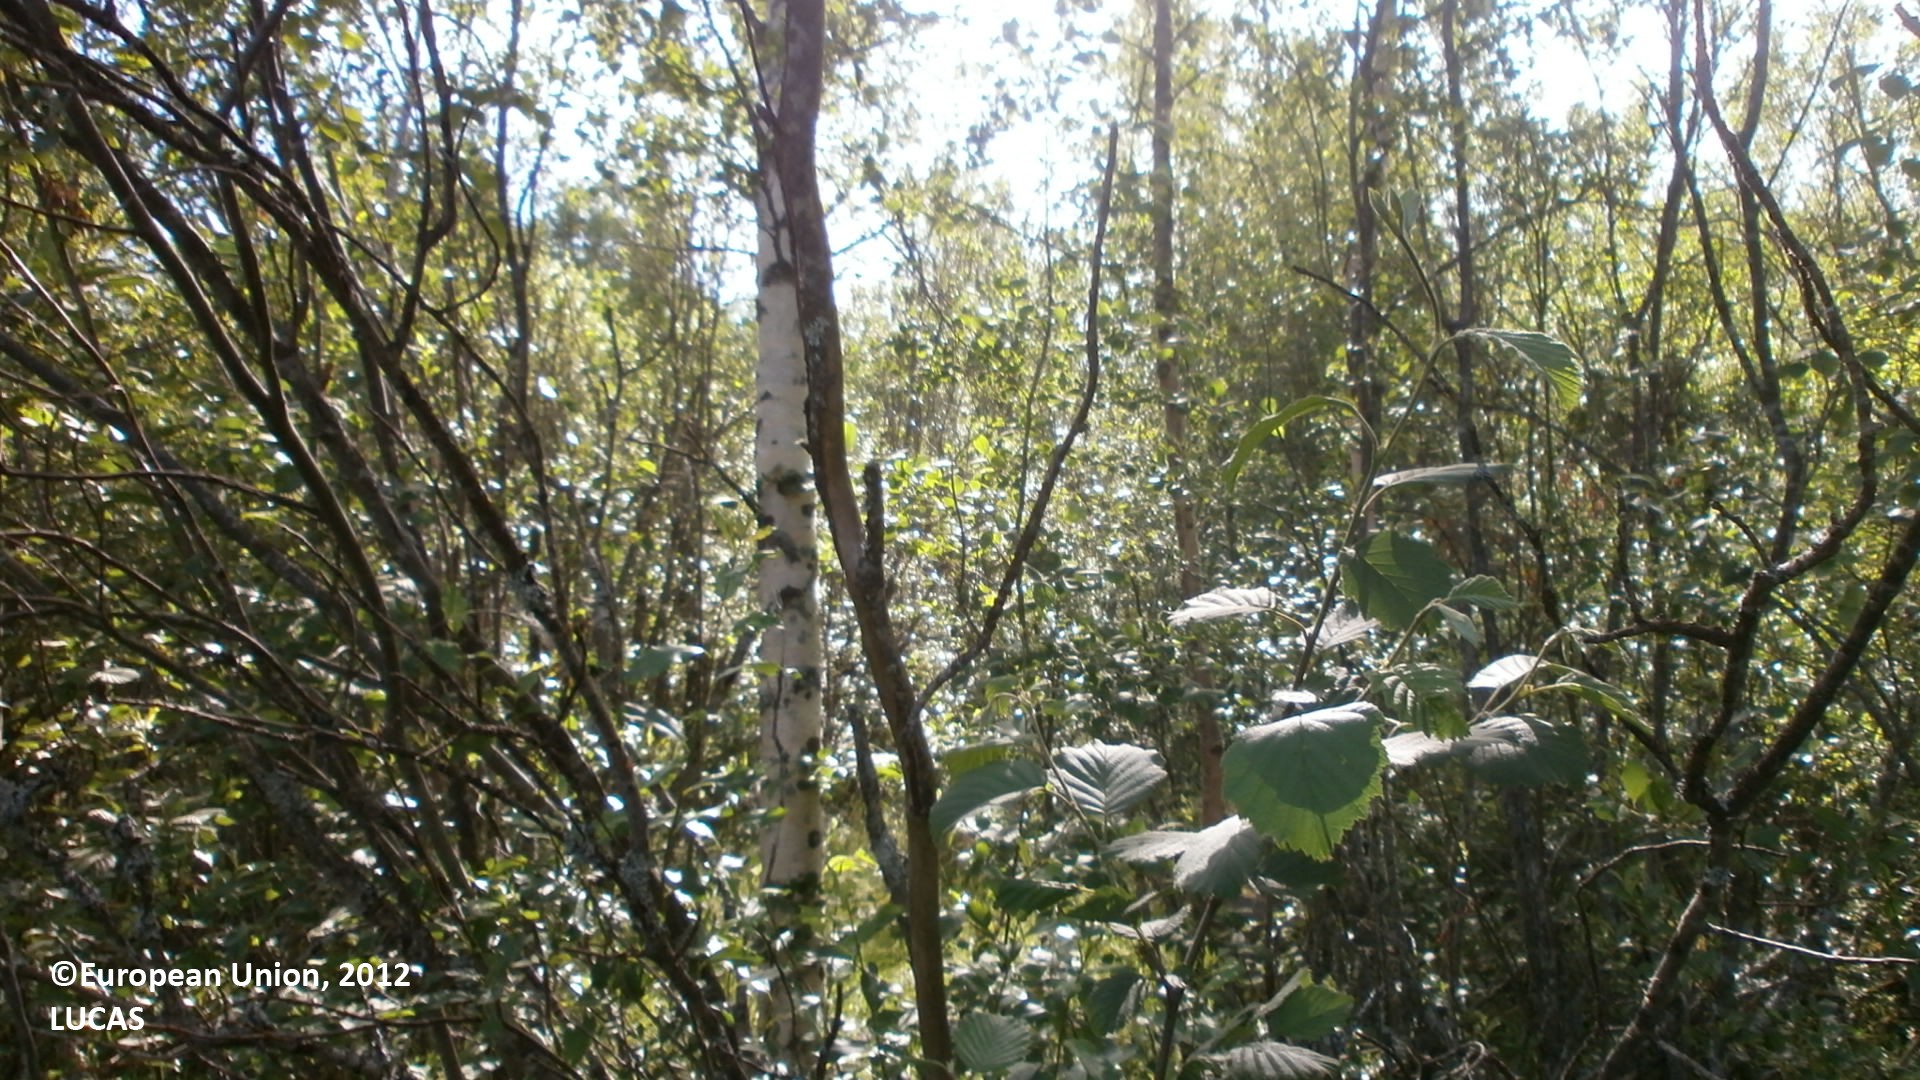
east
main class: Woodland
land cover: Broadleaved woodland
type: boreal forest
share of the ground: > 75 %
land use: Forestry
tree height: > 5 m
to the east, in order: Broadleaved woodland; Ditches and canals; Broadleaved woodland; Ditches and canals; Broadleaved woodland; Spruce dominated mixed woodland; Pine dominated mixed woodland; Ditches and canals; Shruby margins; Tracks; Shruby margins; Ditches and canals; Spontaneously vegetated surfaces; Oats
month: July
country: FI
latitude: 64.4256
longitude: 24.1189
